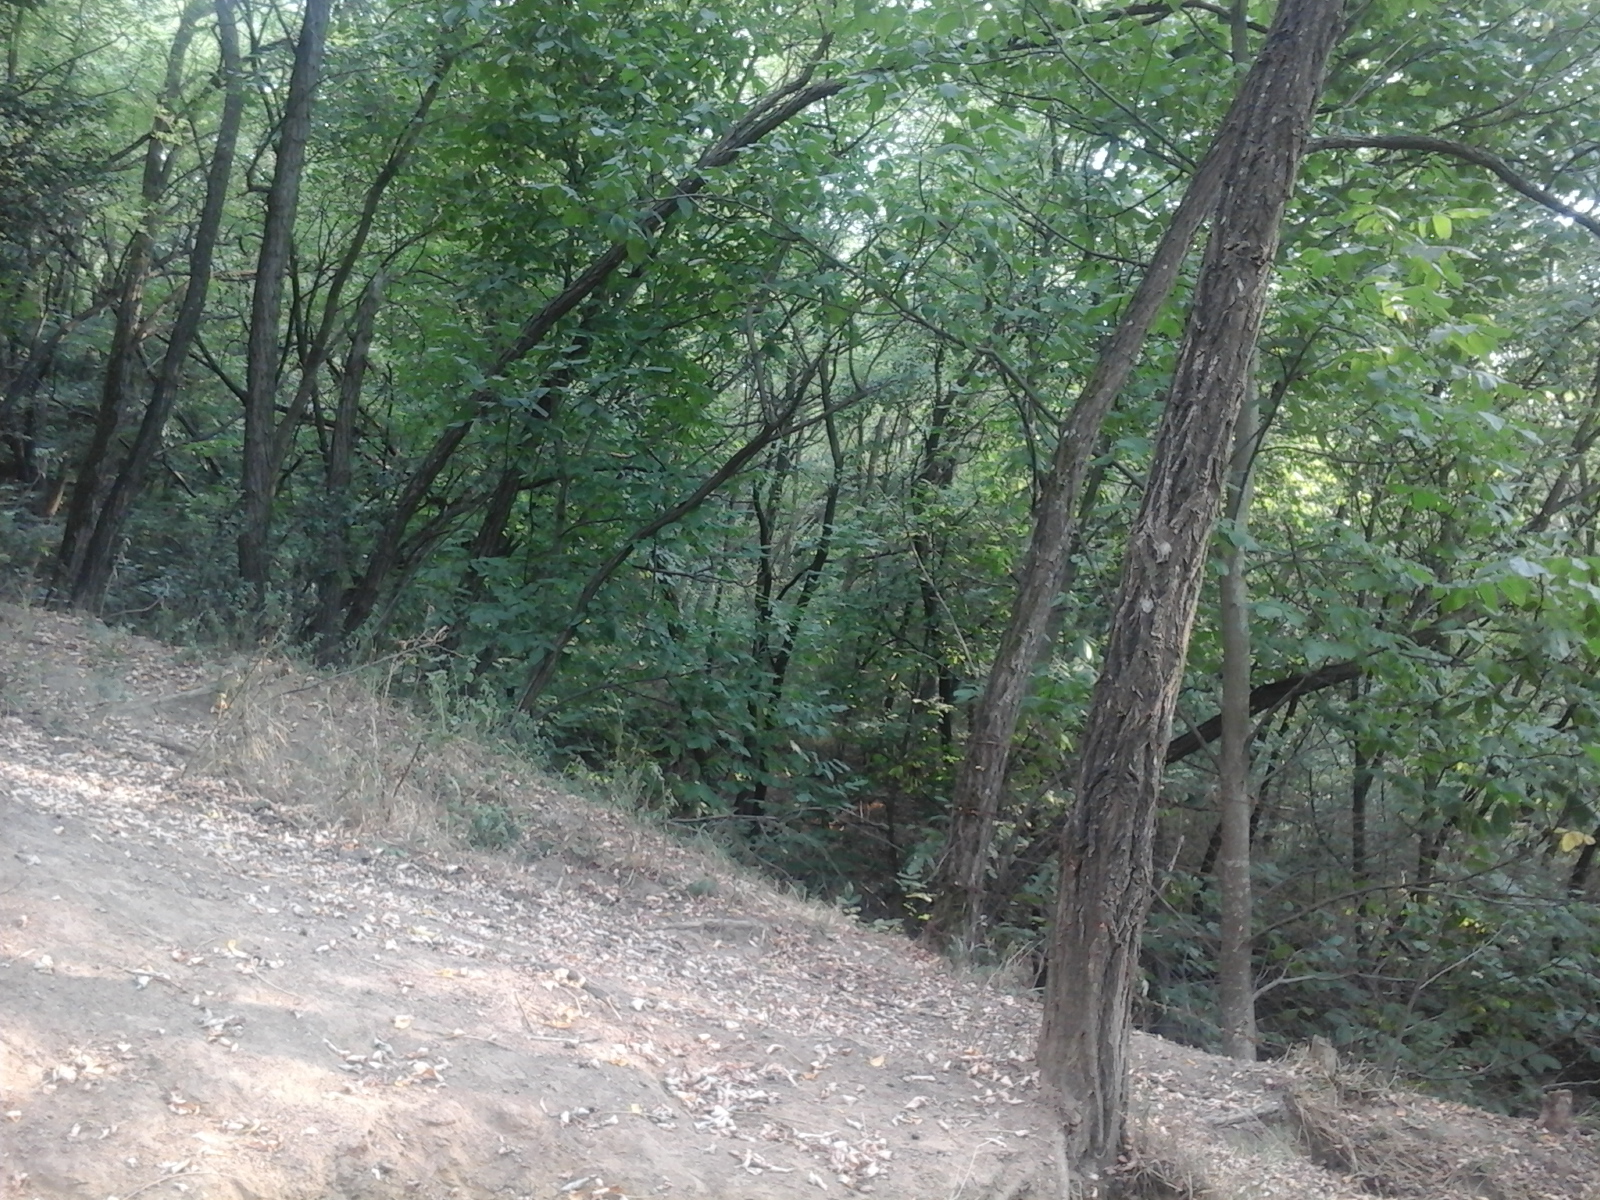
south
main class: Woodland
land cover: Broadleaved woodland
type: beech forest
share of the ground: > 75 %
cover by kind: broadleaved forest trees 100 %
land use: Forestry
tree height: > 5 m
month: August
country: RO
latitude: 44.7717
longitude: 23.6928
